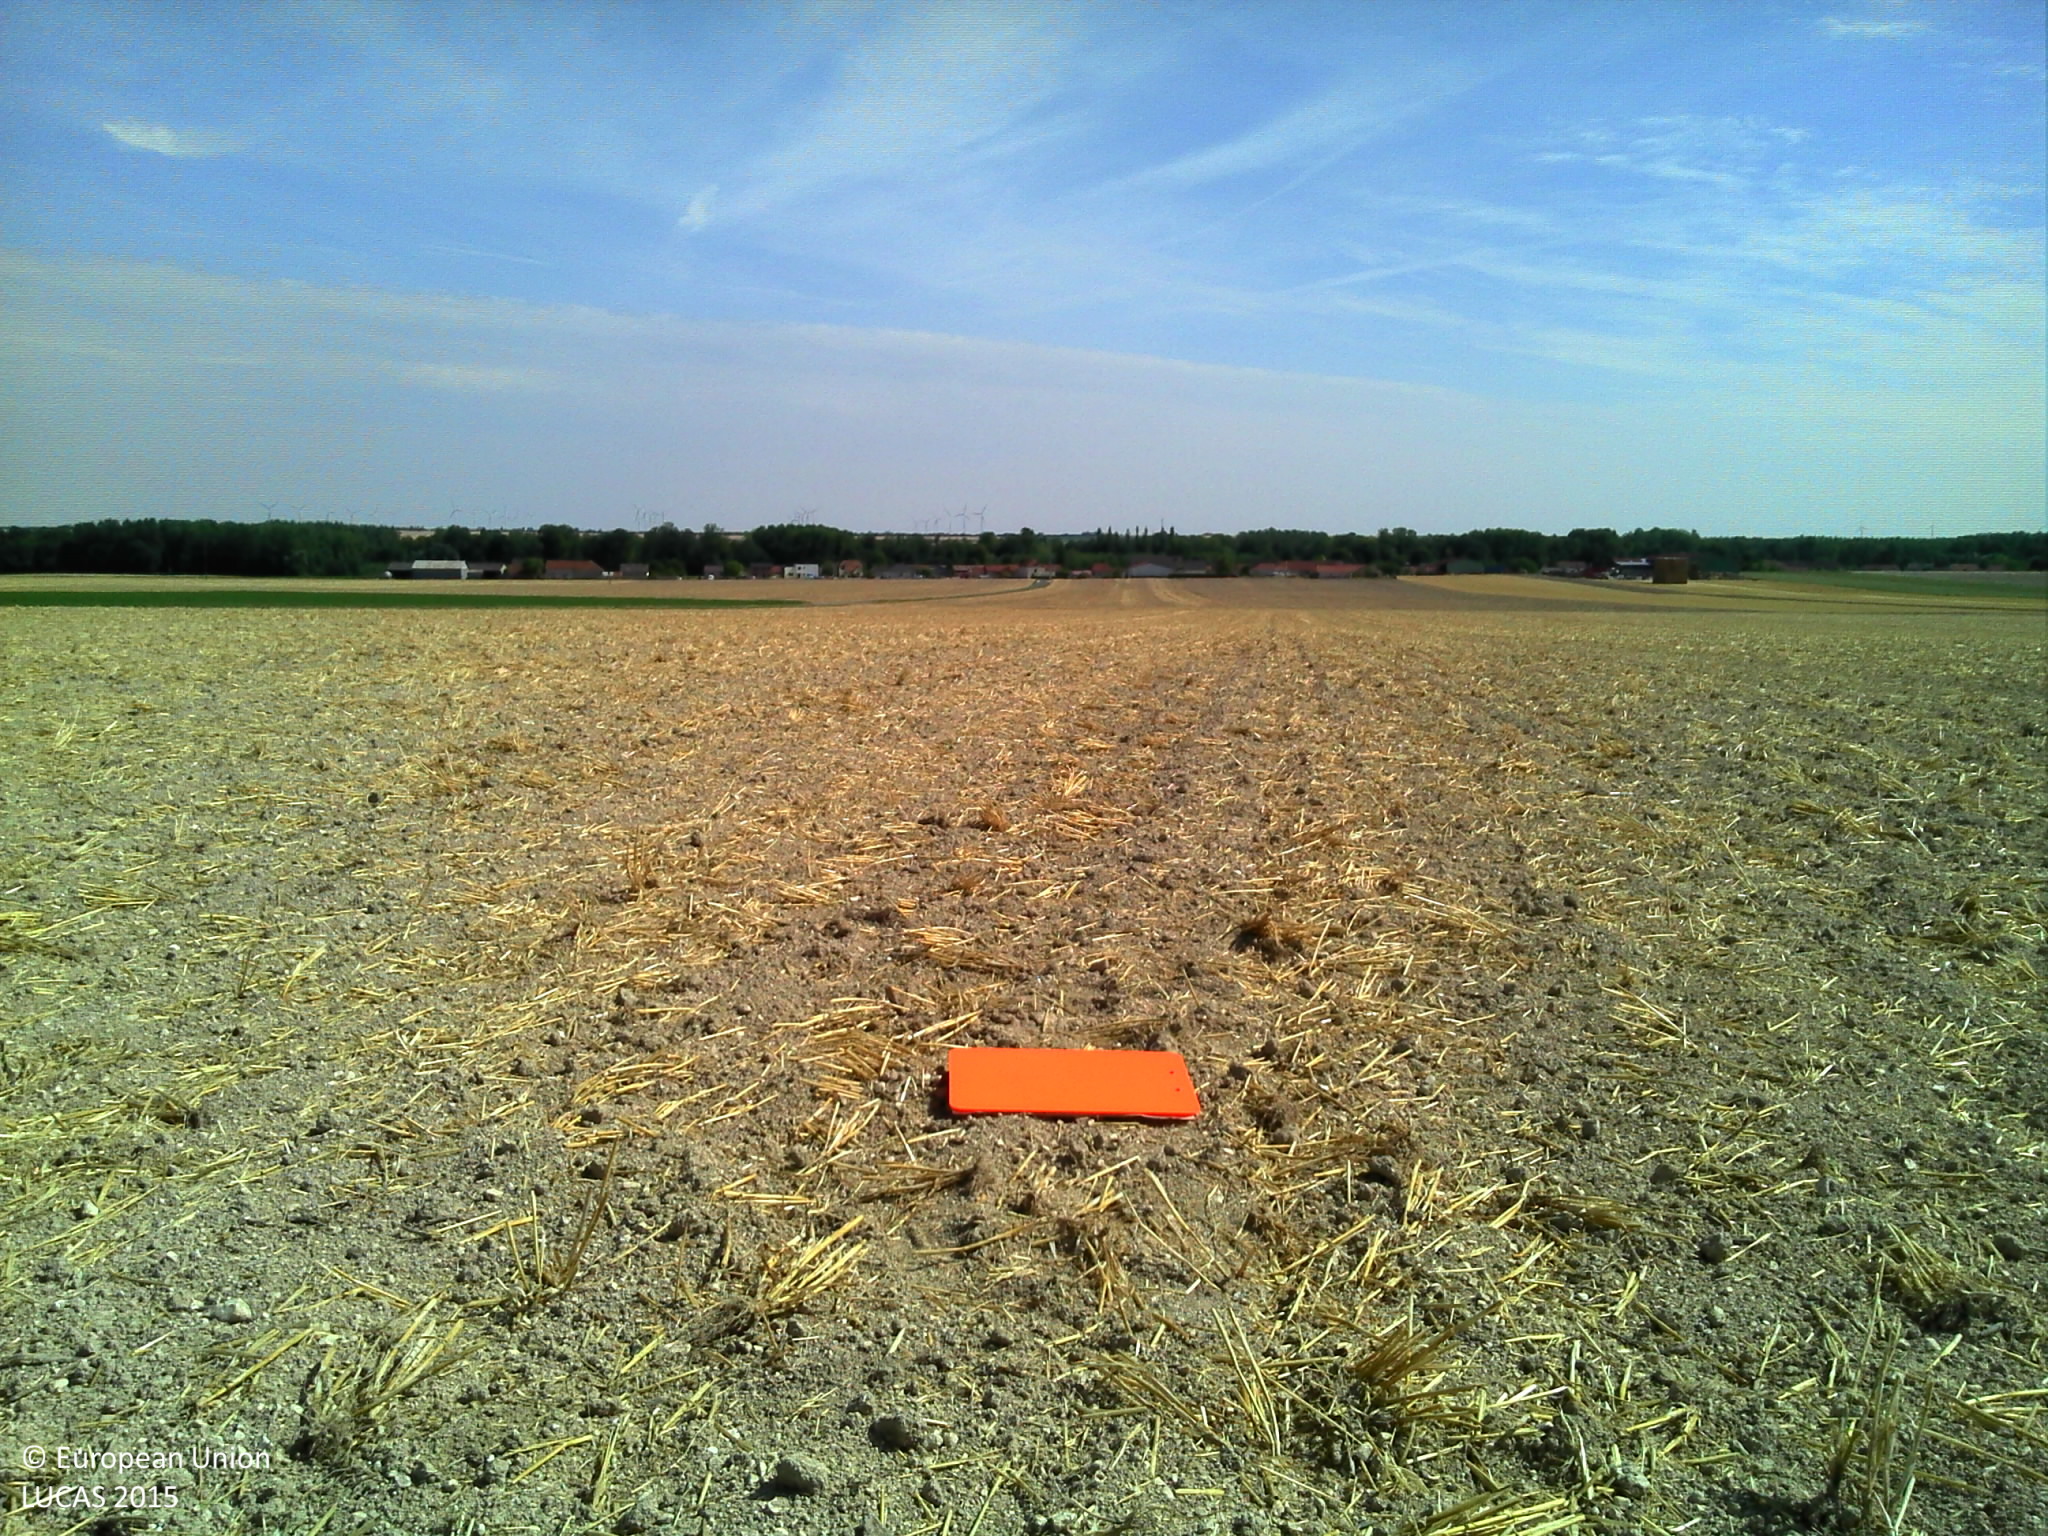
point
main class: Cropland
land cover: Common wheat
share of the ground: > 75 %
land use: Agriculture (excluding fallow land and kitchen gardens)
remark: Tilled/Sowed
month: August
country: FR
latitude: 48.9500
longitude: 4.1102
